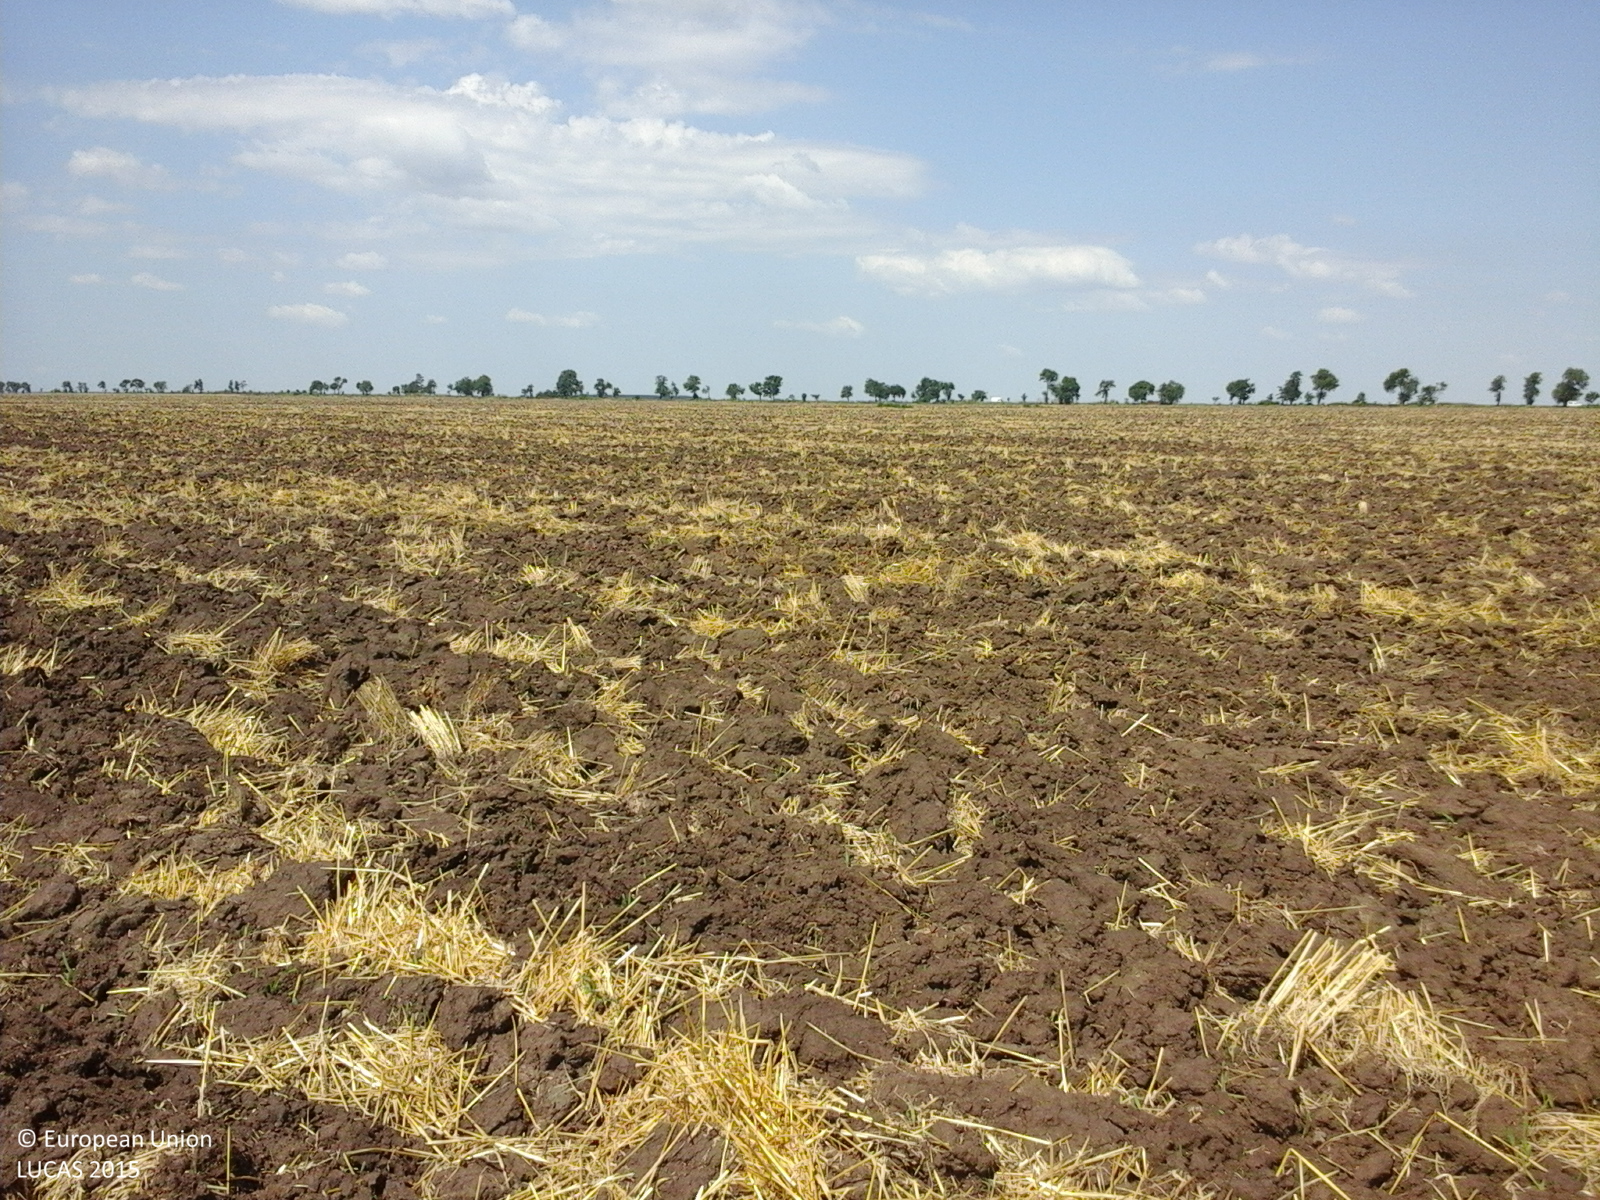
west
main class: Cropland
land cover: Common wheat
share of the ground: < 10 %
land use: Agriculture (excluding fallow land and kitchen gardens)
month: July
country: RO
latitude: 43.9179
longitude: 25.2111
